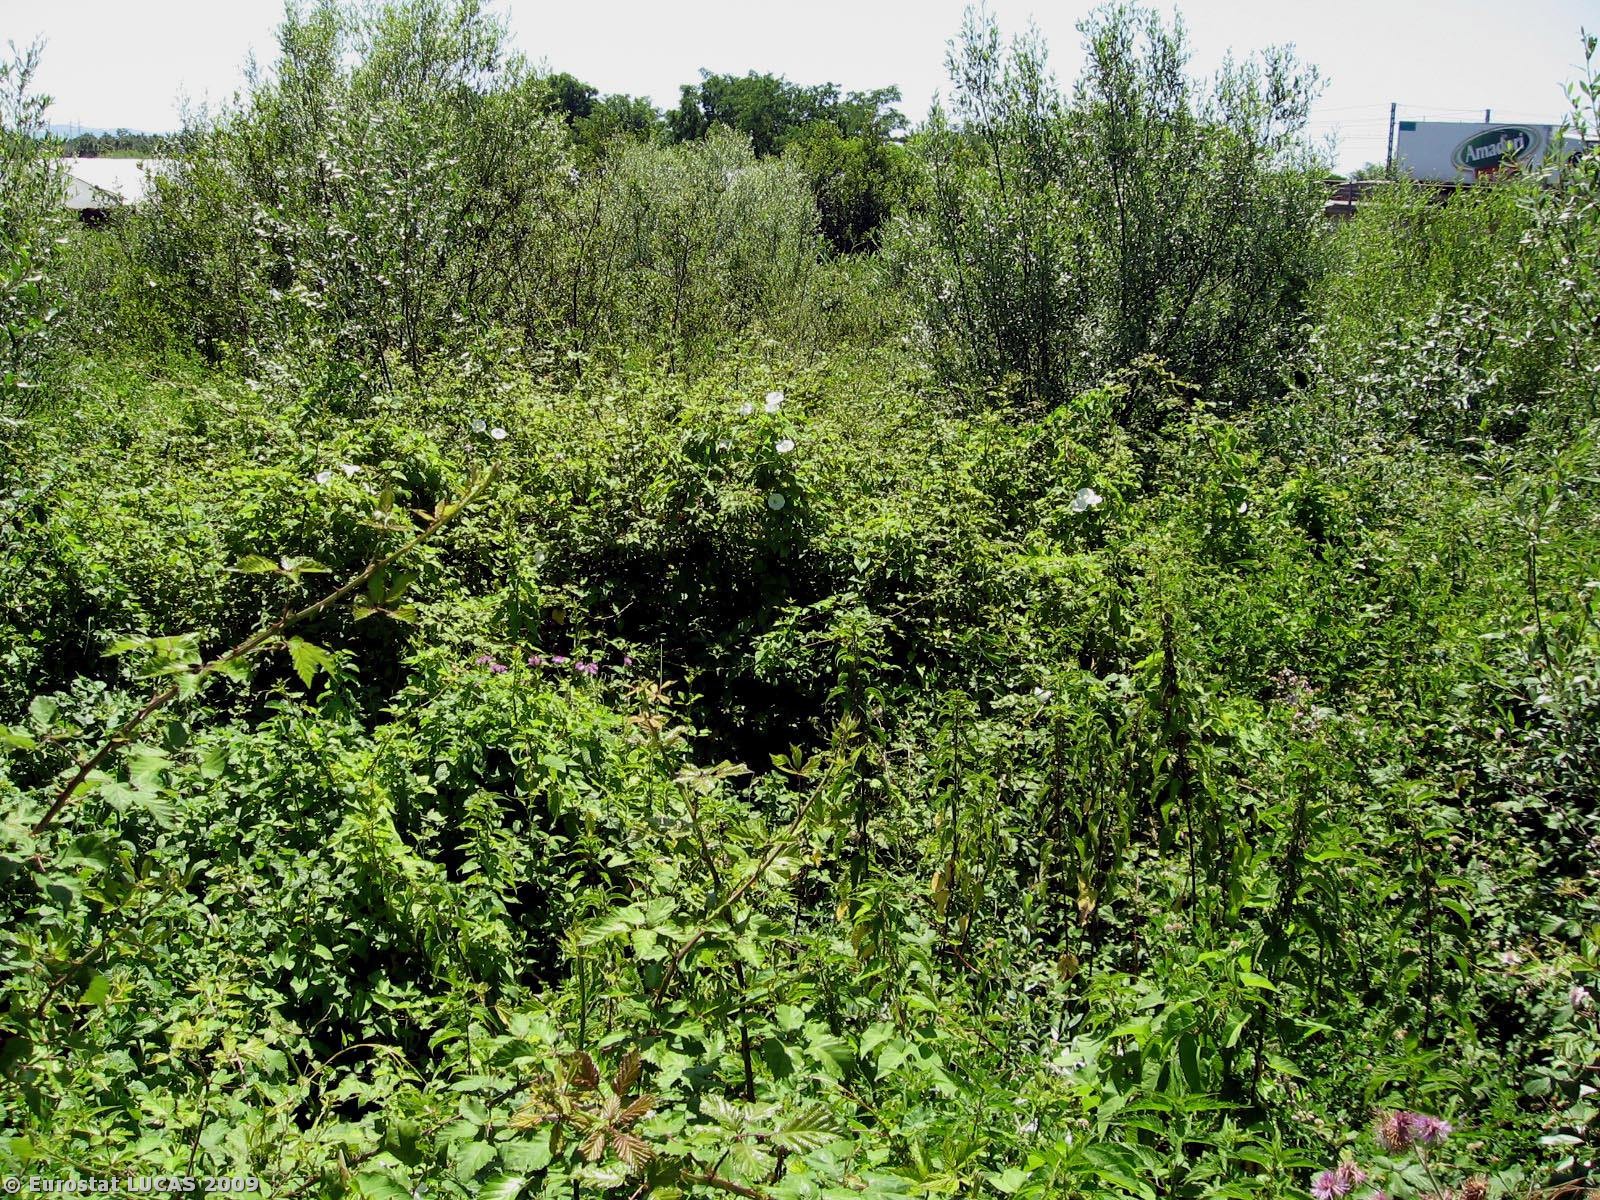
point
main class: Shrubland
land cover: Shrubland with sparse tree cover
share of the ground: > 75 %
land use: Unused
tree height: > 5 m
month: June
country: IT
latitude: 38.8499
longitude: 16.2693
